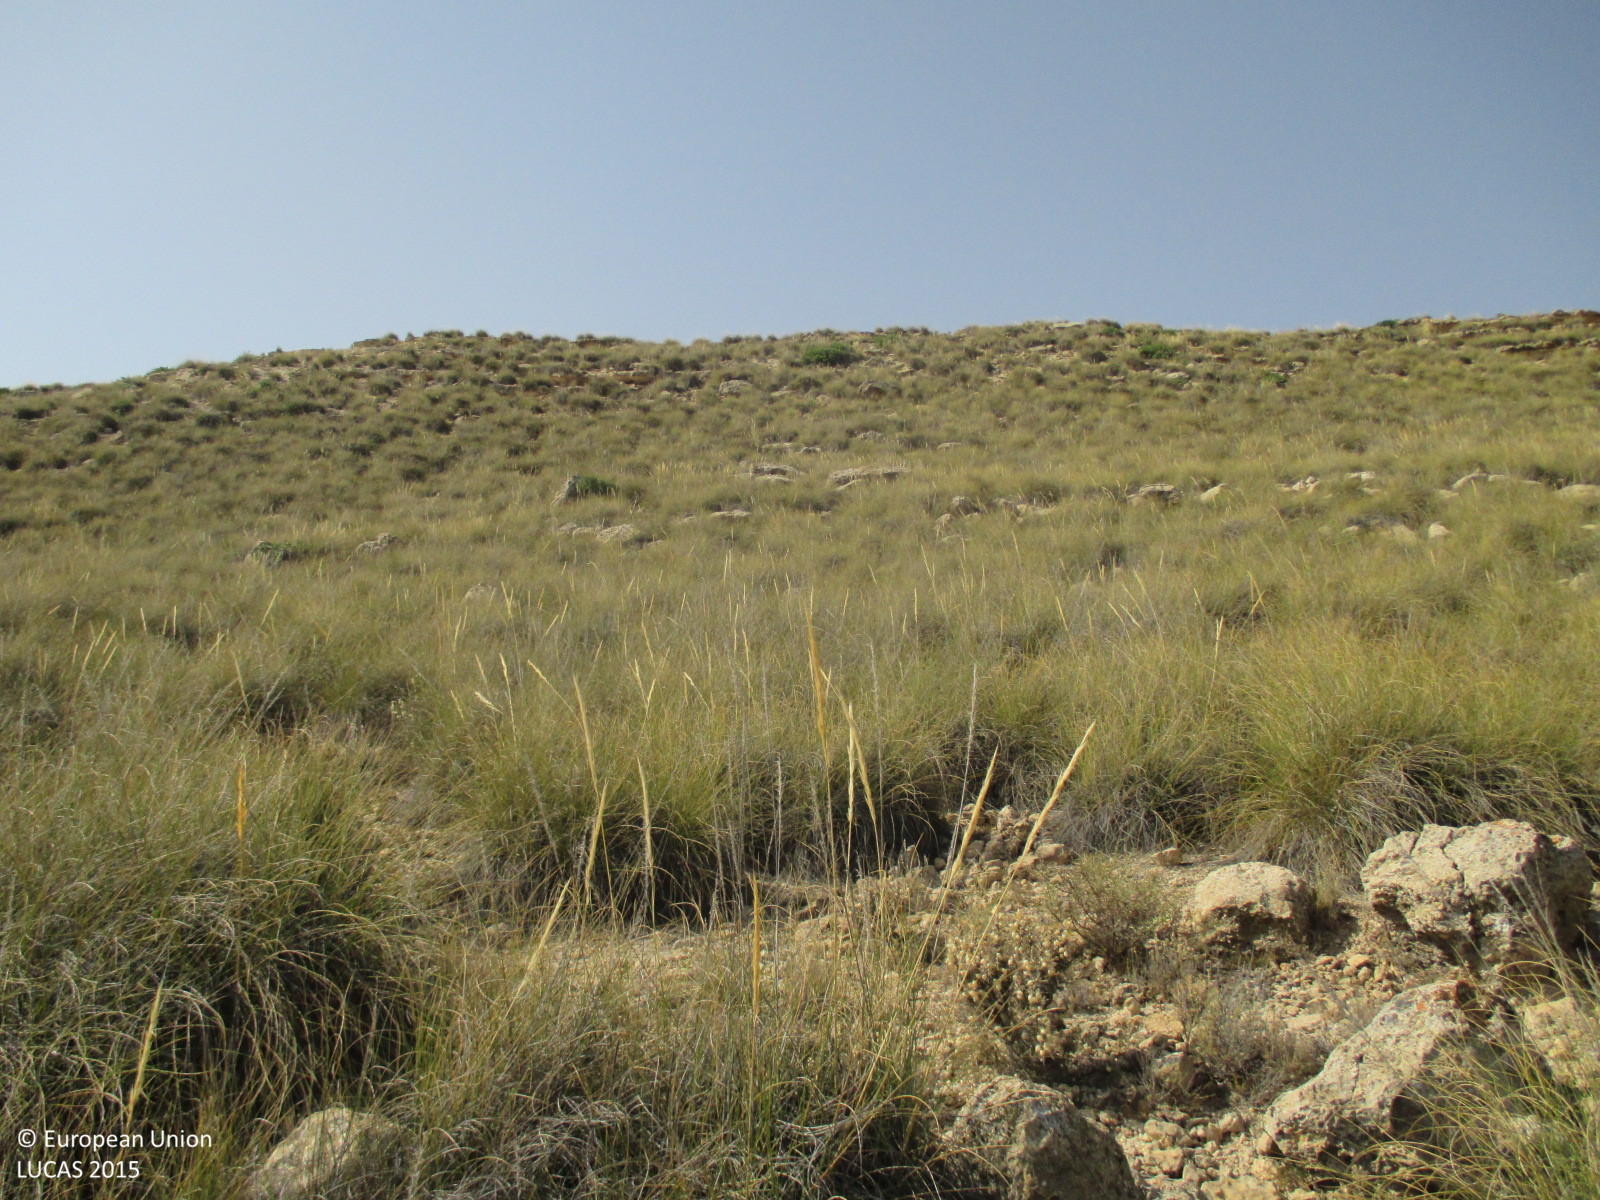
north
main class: Grassland
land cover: Grassland without tree/shrub cover
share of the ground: 50 - 75 %
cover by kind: herbaceous plants 55 %, unconsolidated bare surface 40 %, consolidated bare surface 5 %
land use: Semi-natural and natural areas not in use
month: June
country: ES
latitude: 37.7311
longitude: -2.4581
